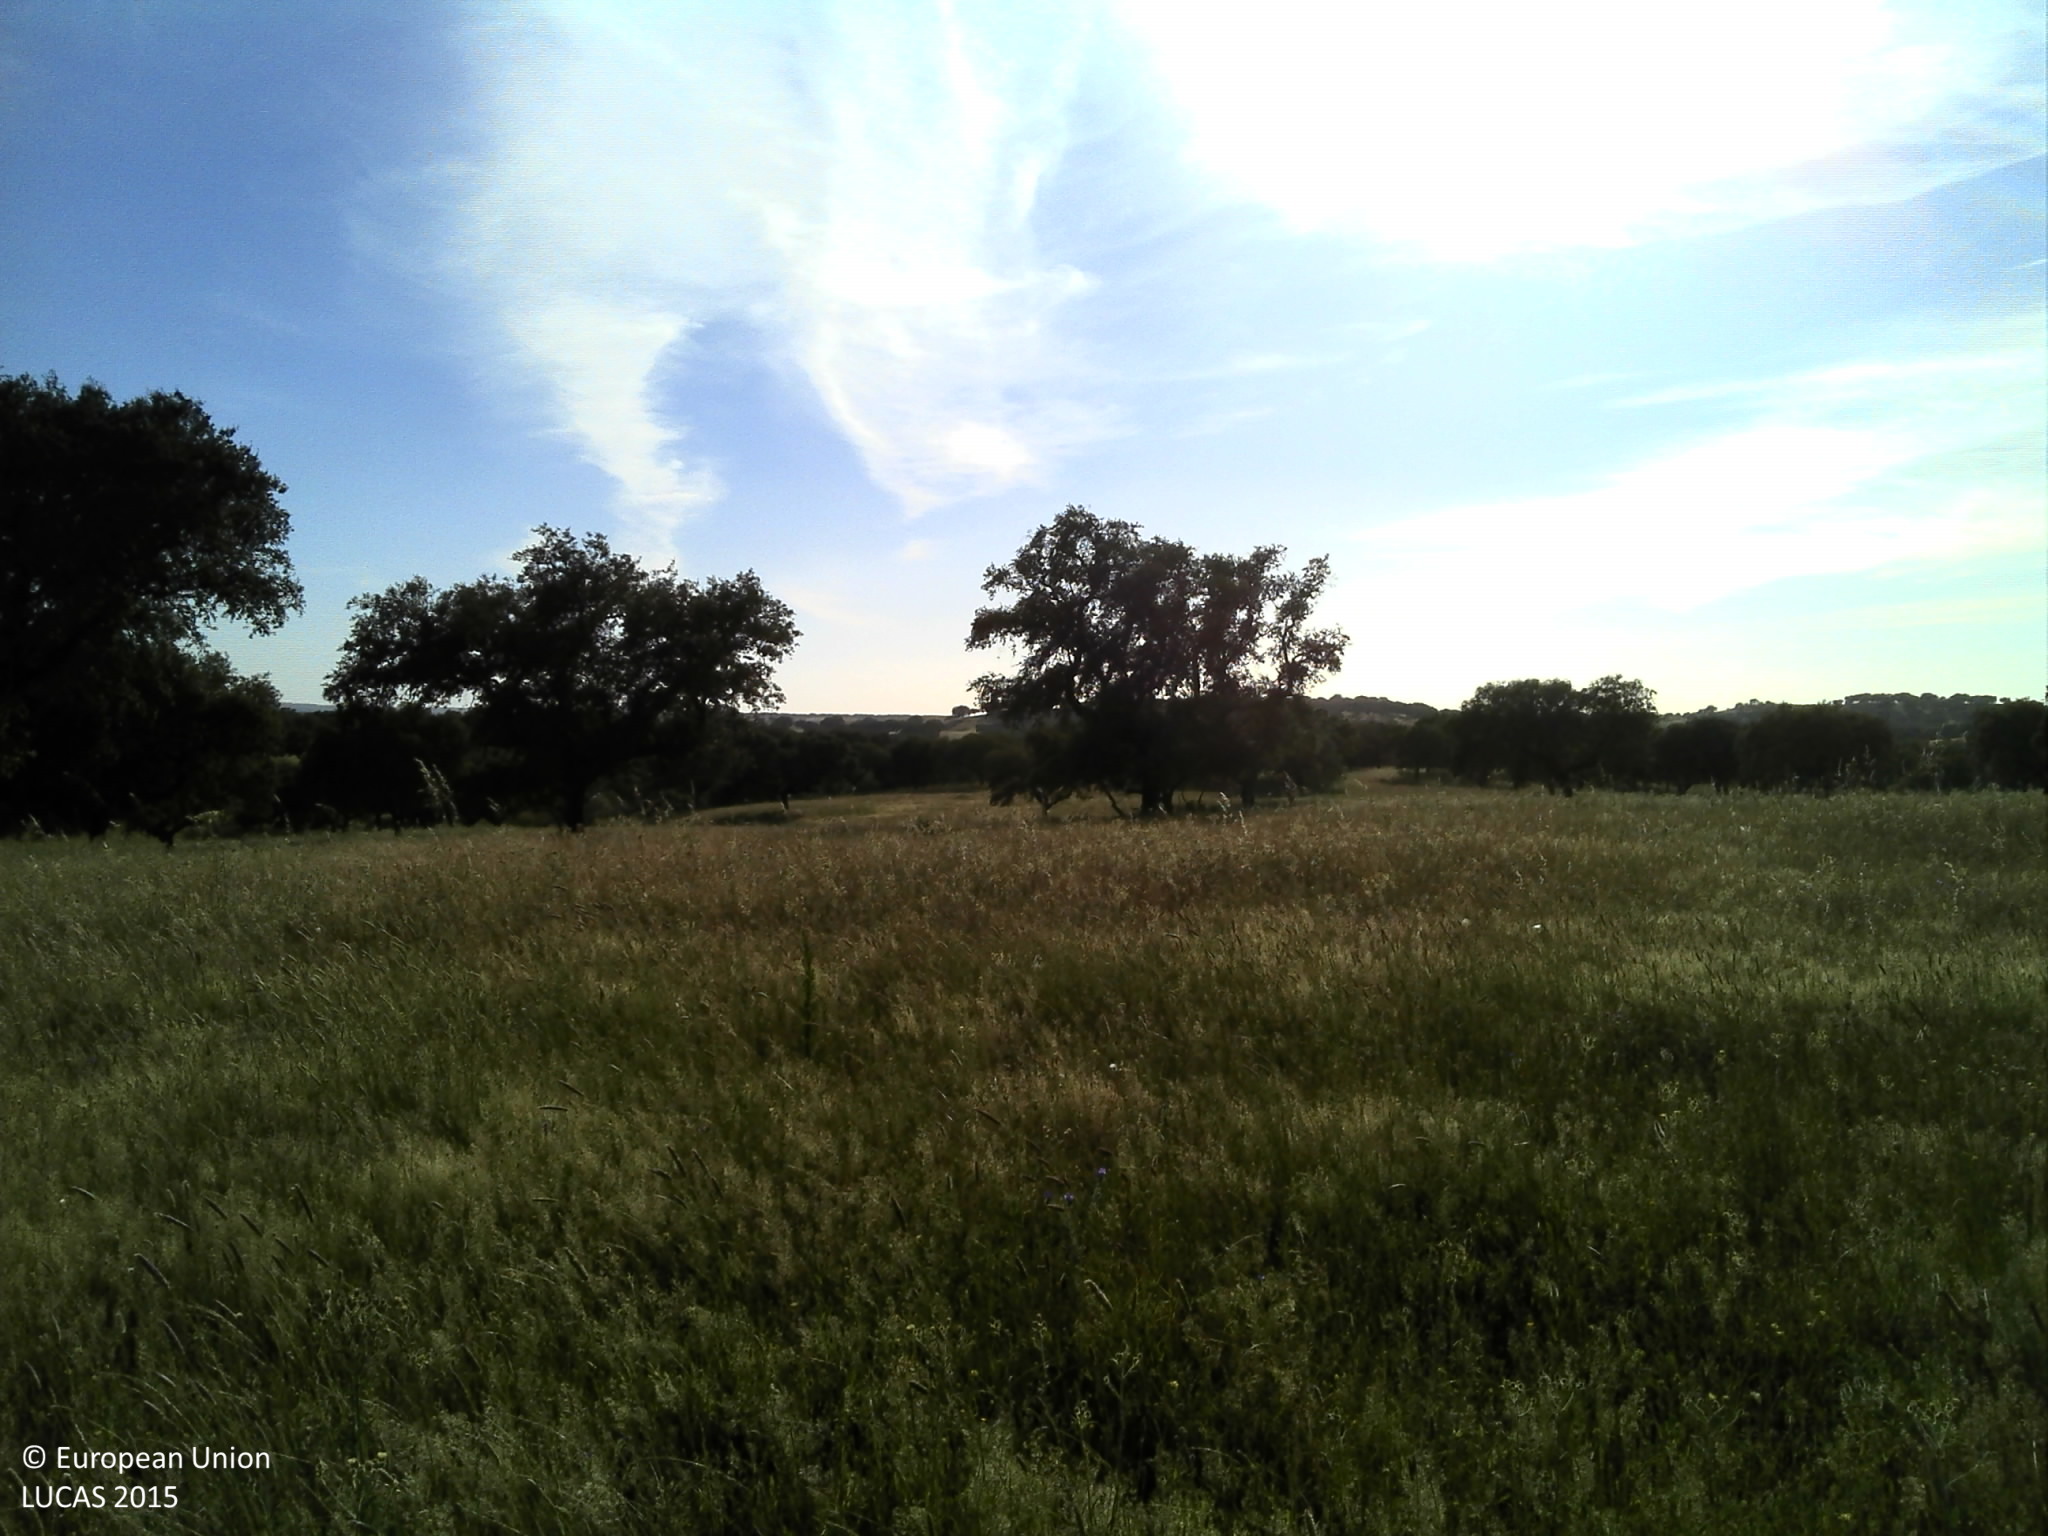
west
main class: Woodland
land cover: Broadleaved woodland
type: broadleaved evergreen forest
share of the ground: 10 - 25 %
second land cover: Grassland without tree/shrub cover
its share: 50 - 75 %
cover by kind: herbaceous plants 75 %, broadleaved forest trees 15 %, unconsolidated bare surface 10 %
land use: Forestry
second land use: Agriculture (excluding fallow land and kitchen gardens)
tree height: > 5 m
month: May
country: PT
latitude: 38.9664
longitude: -7.9484
